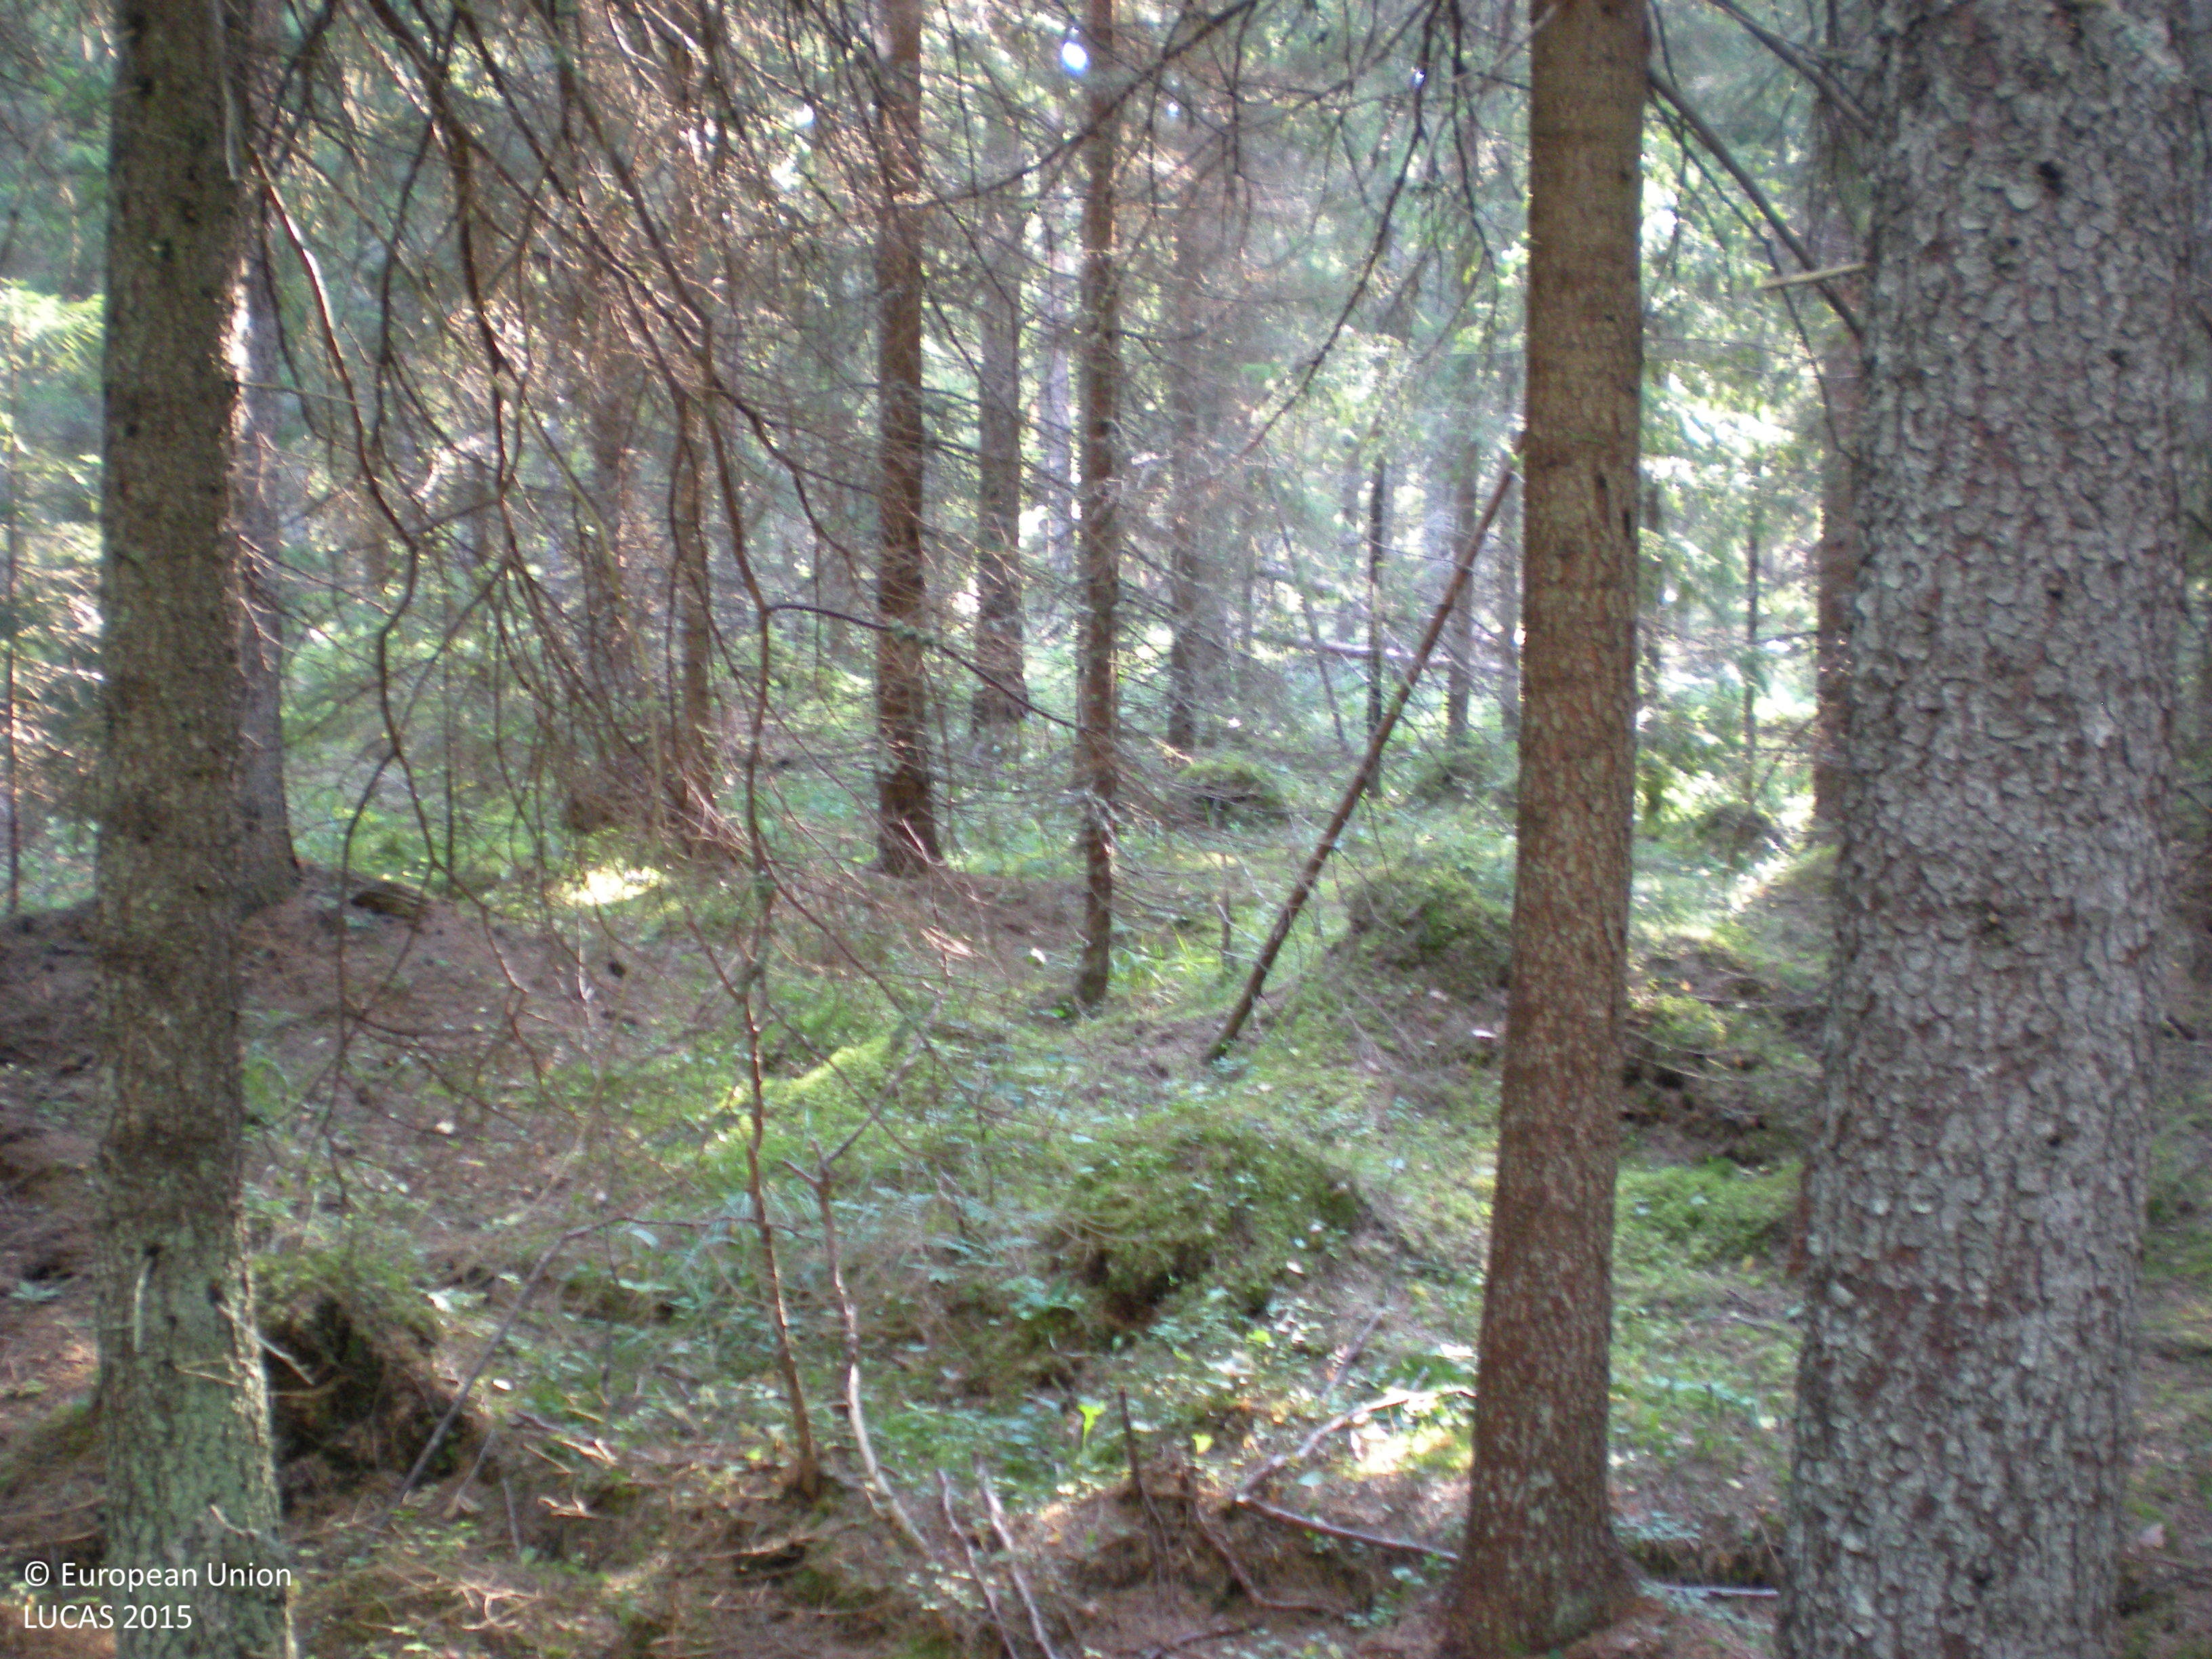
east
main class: Woodland
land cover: Spruce dominated coniferous woodland
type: boreal forest
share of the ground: > 75 %
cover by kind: coniferous forest trees 80 %, herbaceous plants 10 %, shrubs 5 %
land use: Forestry
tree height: > 5 m
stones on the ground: < 10 %
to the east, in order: Spruce dominated coniferous woodland; Other coniferous woodland; Spruce dominated mixed woodland; Ditches and canals; Spruce dominated mixed woodland; Spruce dominated coniferous woodland
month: August
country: SE
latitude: 60.5485
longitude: 17.3745
